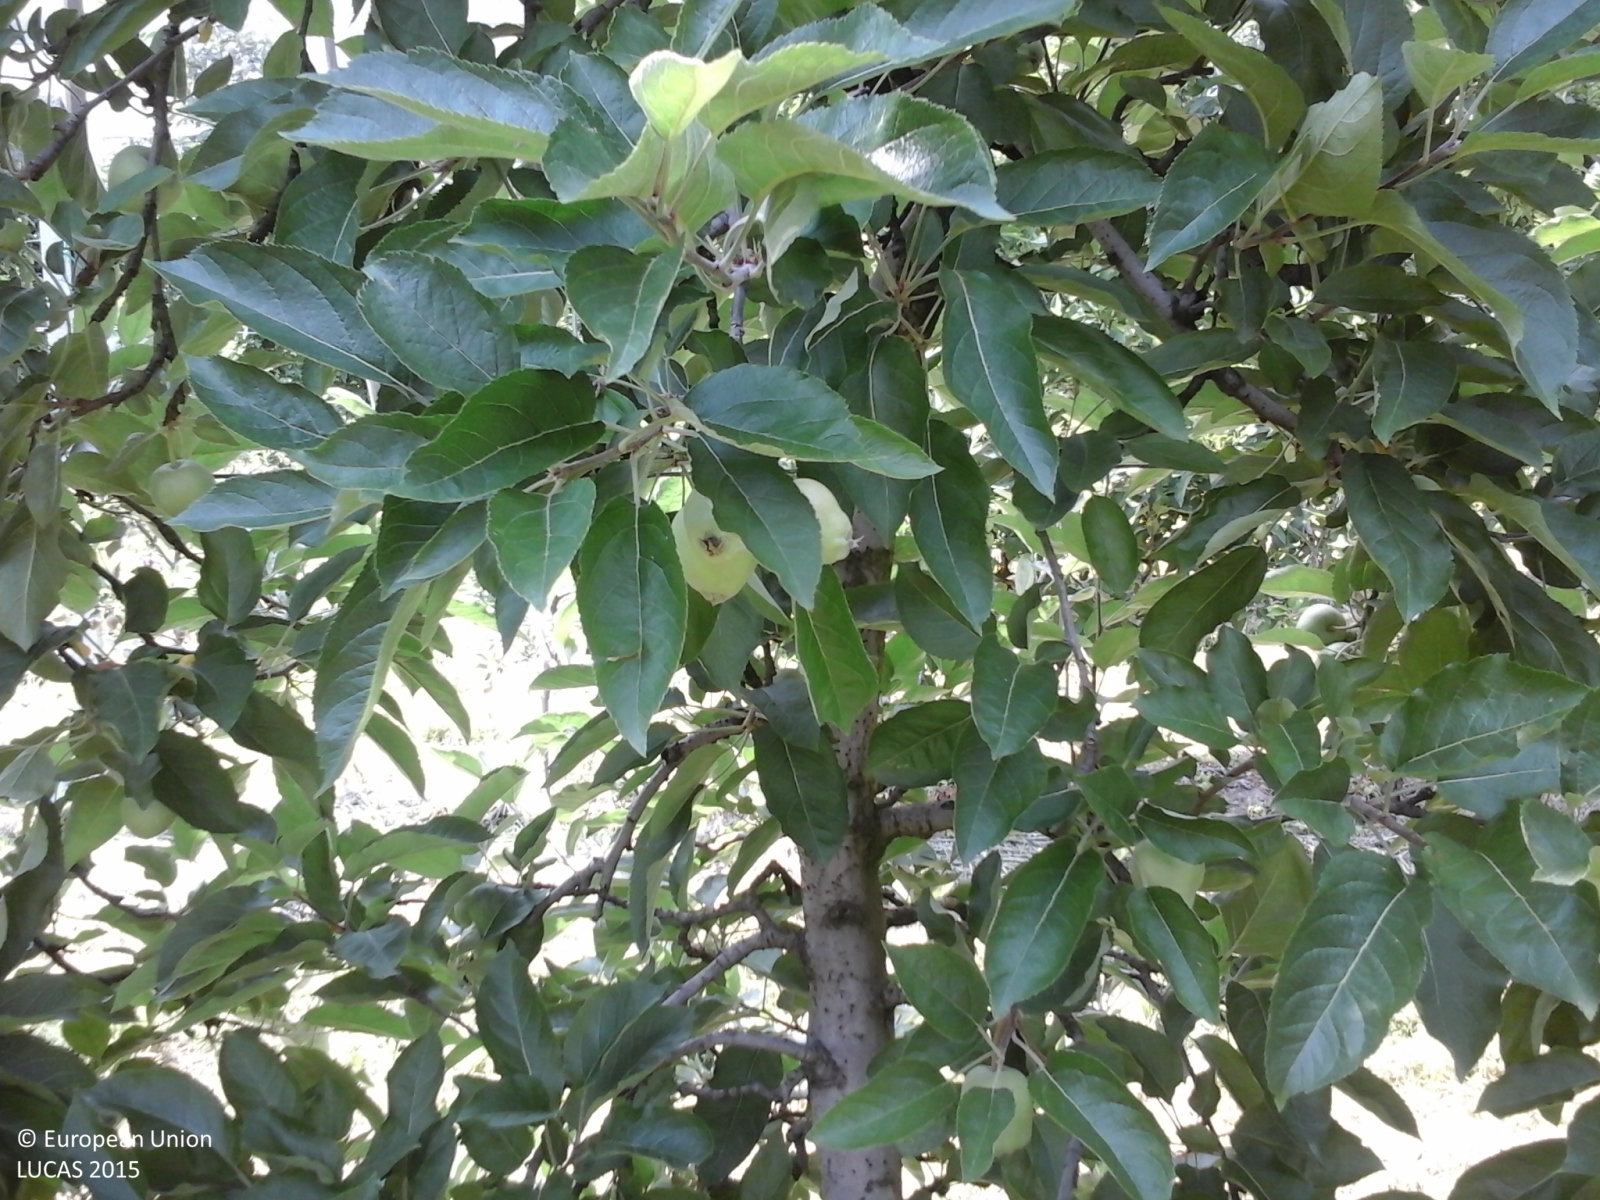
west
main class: Cropland
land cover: Apple fruit
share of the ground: > 75 %
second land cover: Grassland without tree/shrub cover
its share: > 75 %
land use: Agriculture (excluding fallow land and kitchen gardens)
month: June
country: IT
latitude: 46.7048
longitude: 11.1889
